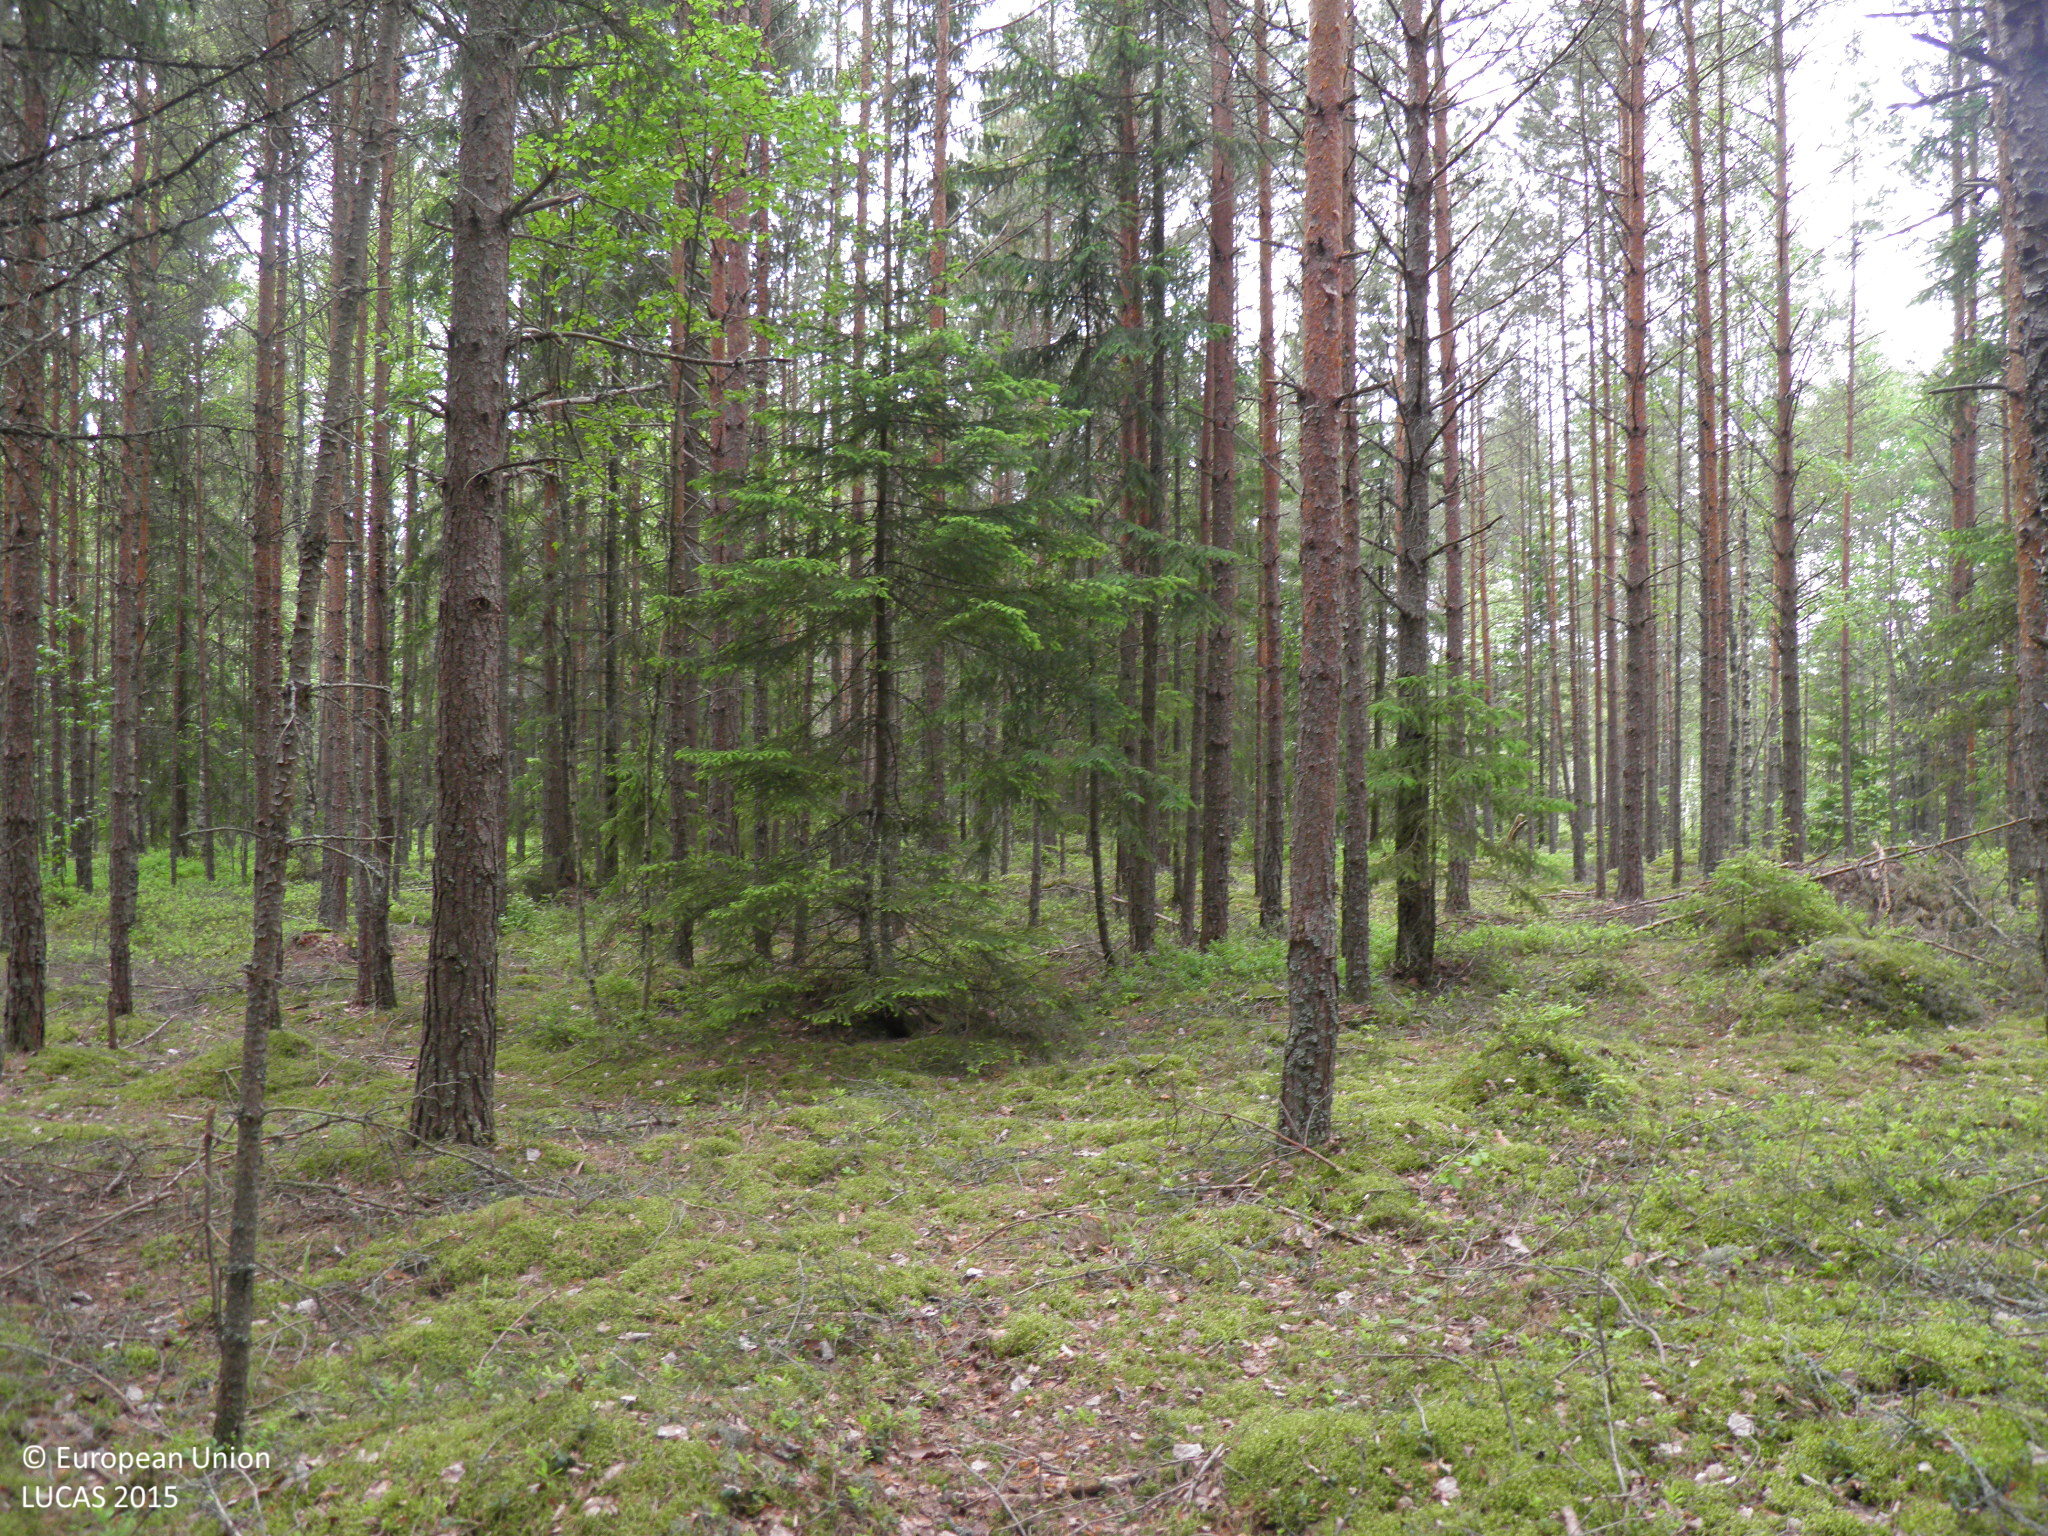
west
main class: Woodland
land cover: Pine dominated coniferous woodland
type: boreal forest
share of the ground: > 75 %
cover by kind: coniferous forest trees 80 %, lichens and mosses 10 %, broadleaved forest trees 5 %, shrubs 5 %
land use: Forestry
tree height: > 5 m
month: June
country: FI
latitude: 60.2751
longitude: 22.7499
